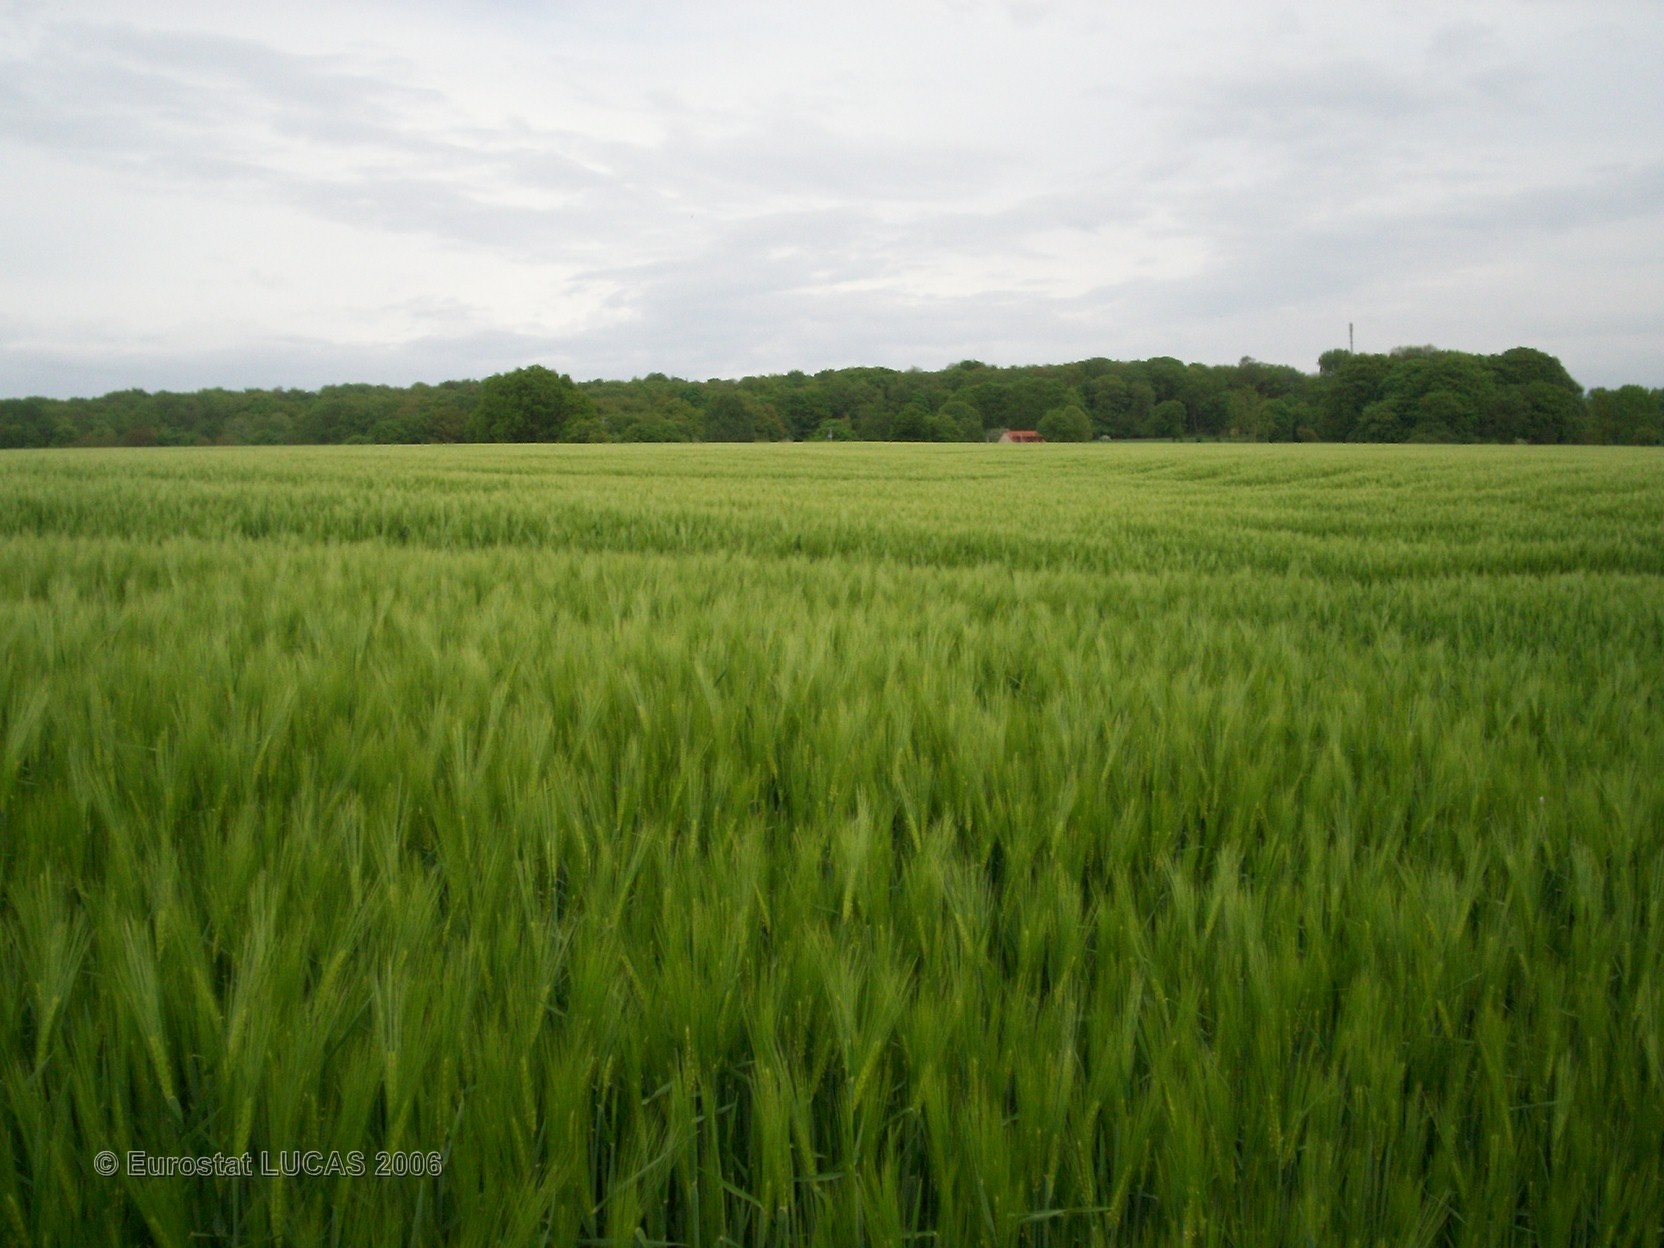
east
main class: Cropland
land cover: Barley
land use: Agriculture (excluding fallow land and kitchen gardens)
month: May
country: FR
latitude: 50.3792
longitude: 2.6335
